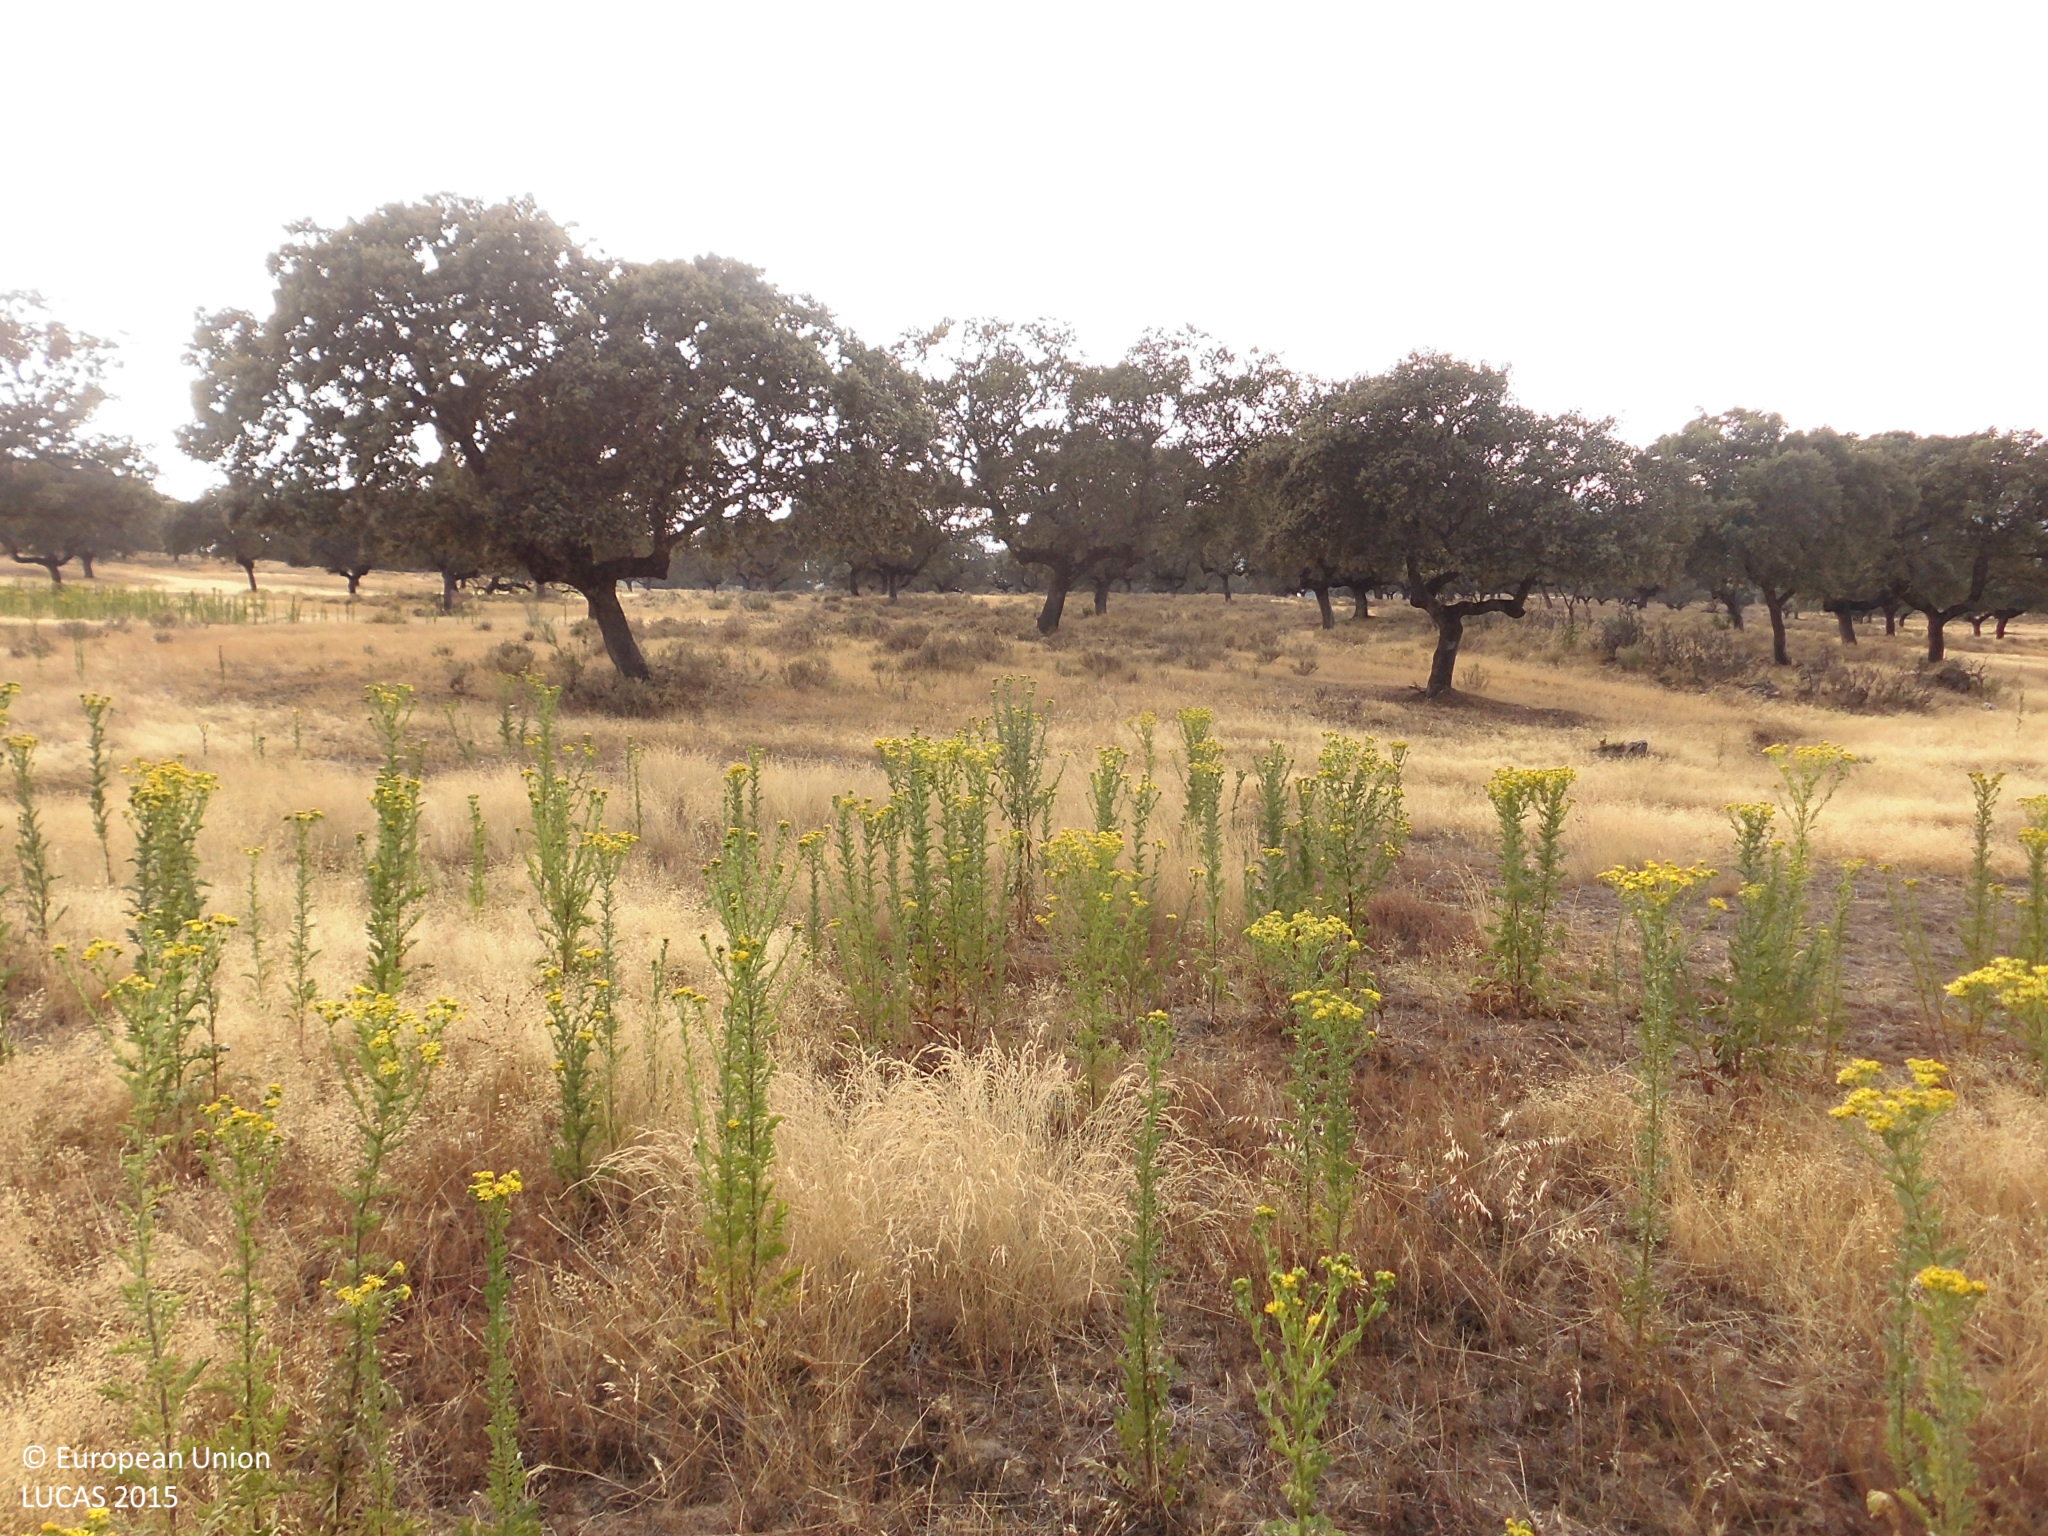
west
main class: Woodland
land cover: Broadleaved woodland
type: broadleaved evergreen forest
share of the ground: 10 - 25 %
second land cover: Grassland without tree/shrub cover
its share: > 75 %
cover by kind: herbaceous plants 90 %, broadleaved forest trees 10 %
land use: Forestry
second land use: Agriculture (excluding fallow land and kitchen gardens)
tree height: > 5 m
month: June
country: ES
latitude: 39.8164
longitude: -6.1794
